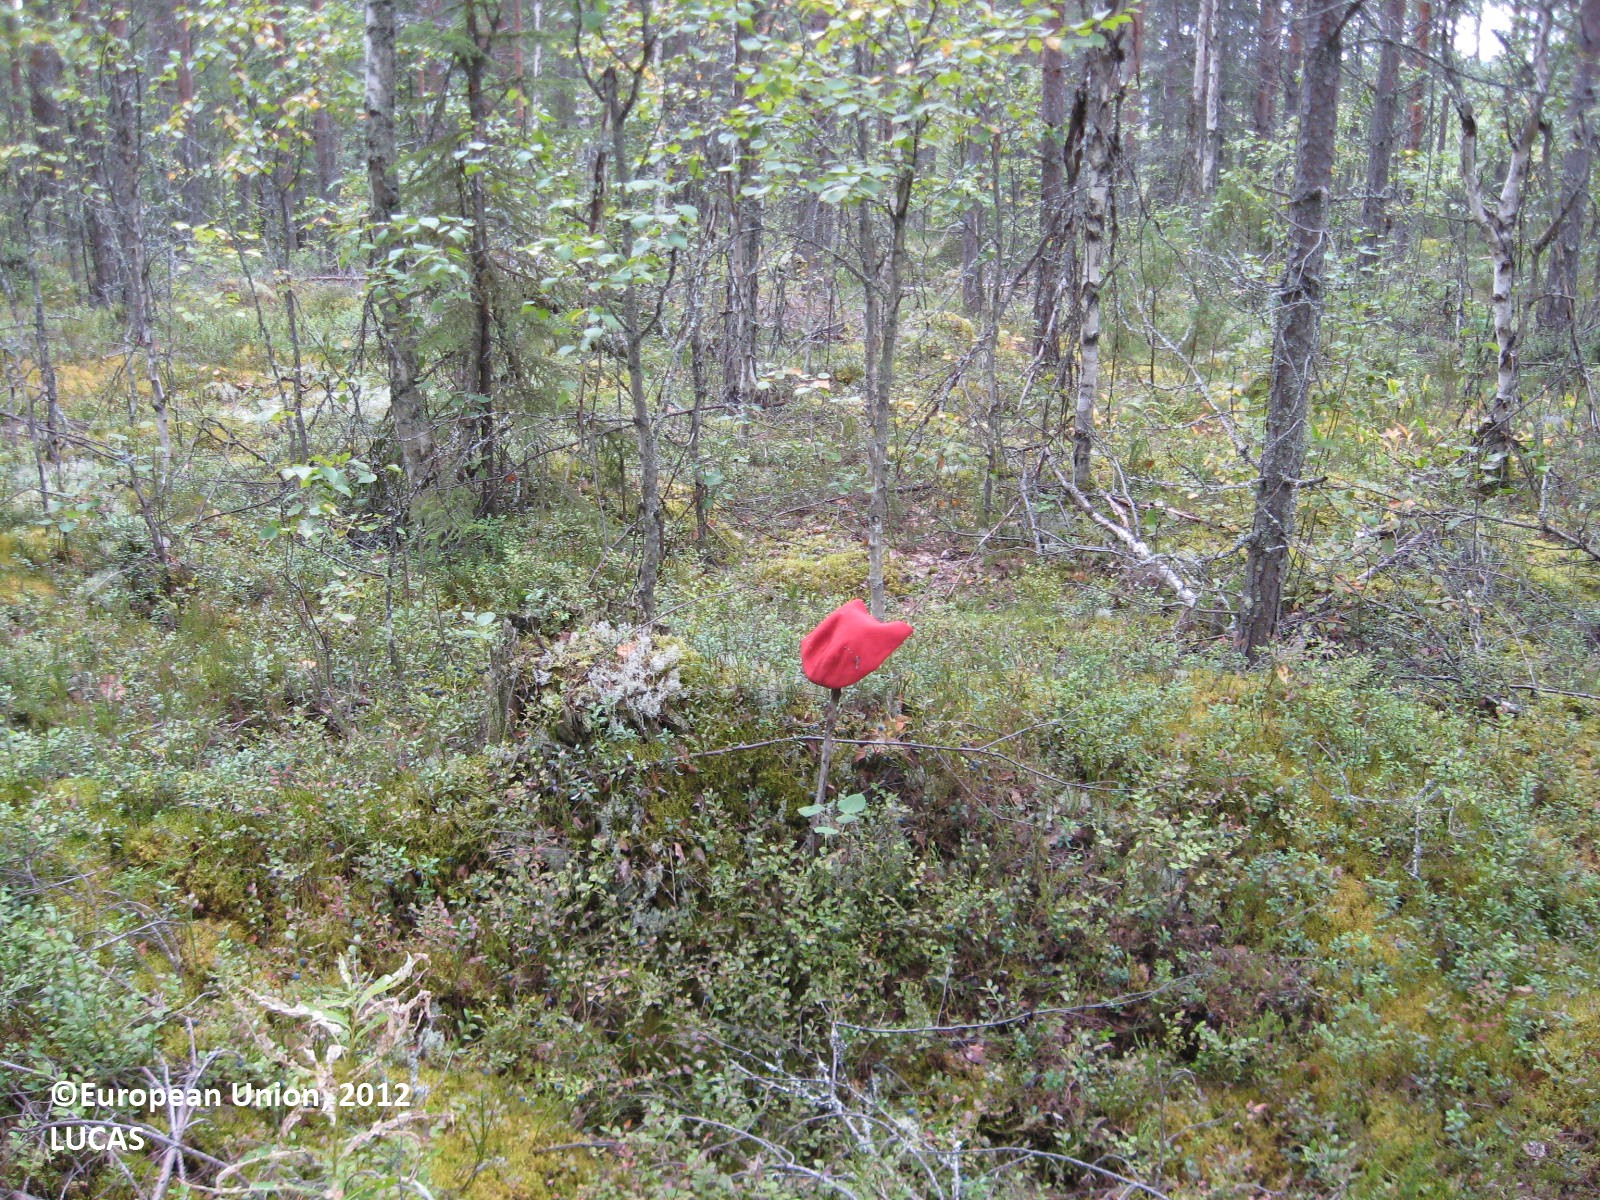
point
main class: Woodland
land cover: Pine dominated mixed woodland
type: boreal forest
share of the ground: > 75 %
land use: Forestry
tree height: > 5 m
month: August
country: FI
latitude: 63.3924
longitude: 30.2110
